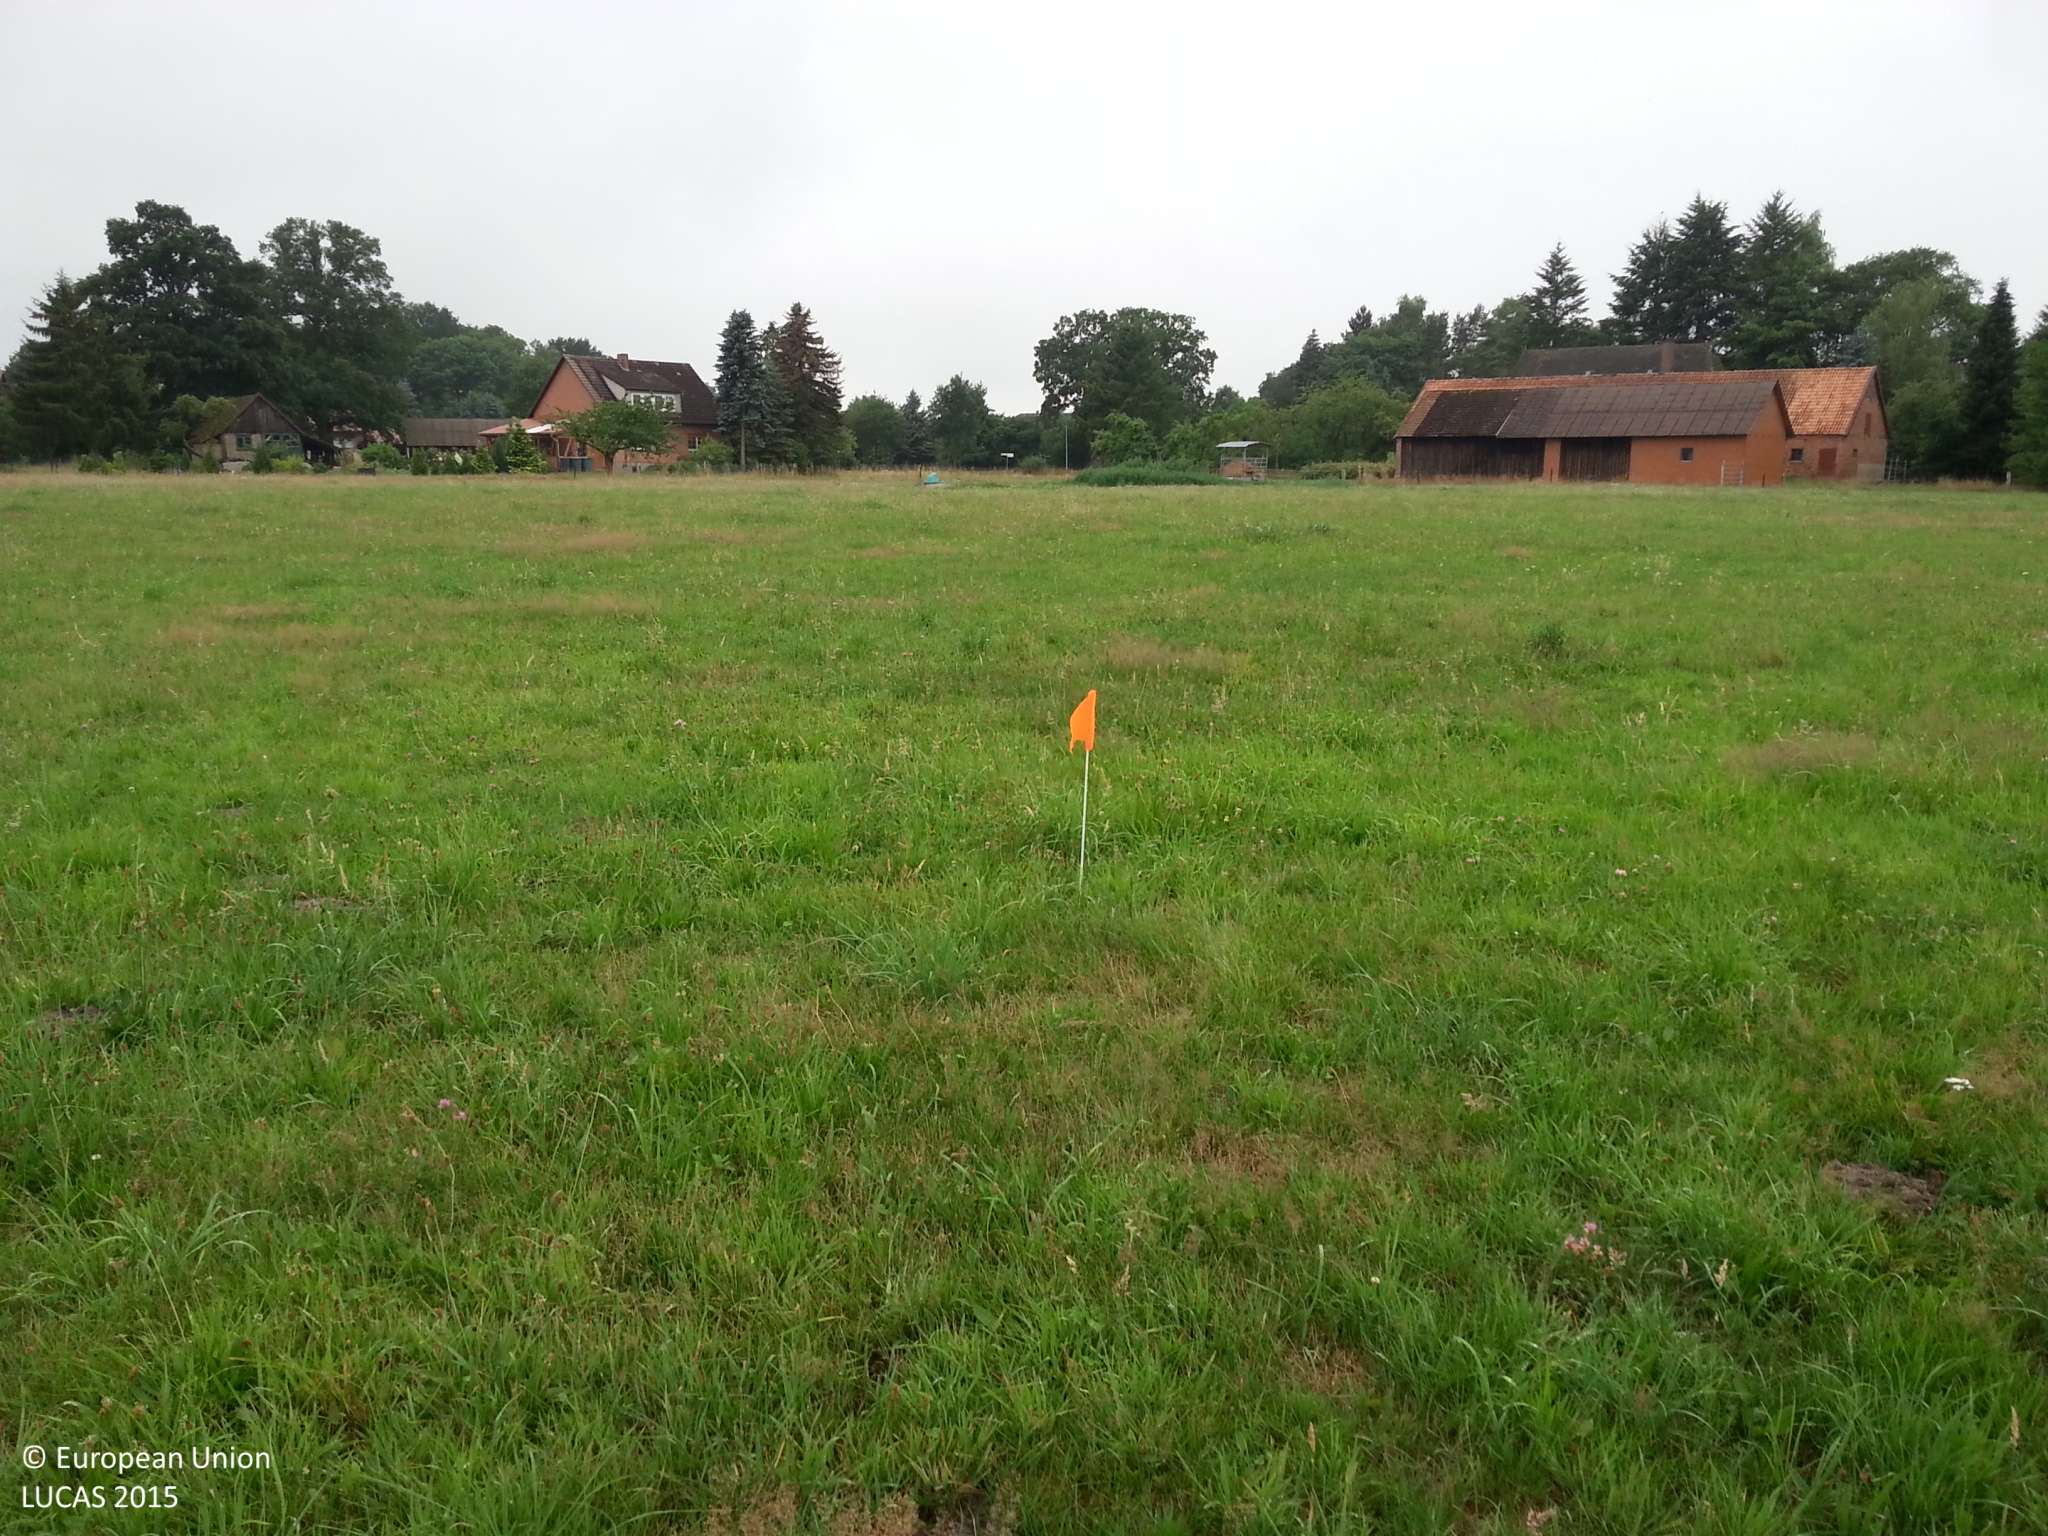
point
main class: Grassland
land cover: Grassland without tree/shrub cover
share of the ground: > 75 %
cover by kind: herbaceous plants 100 %
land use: Agriculture (excluding fallow land and kitchen gardens)
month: July
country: DE
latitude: 53.0550
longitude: 11.1484
